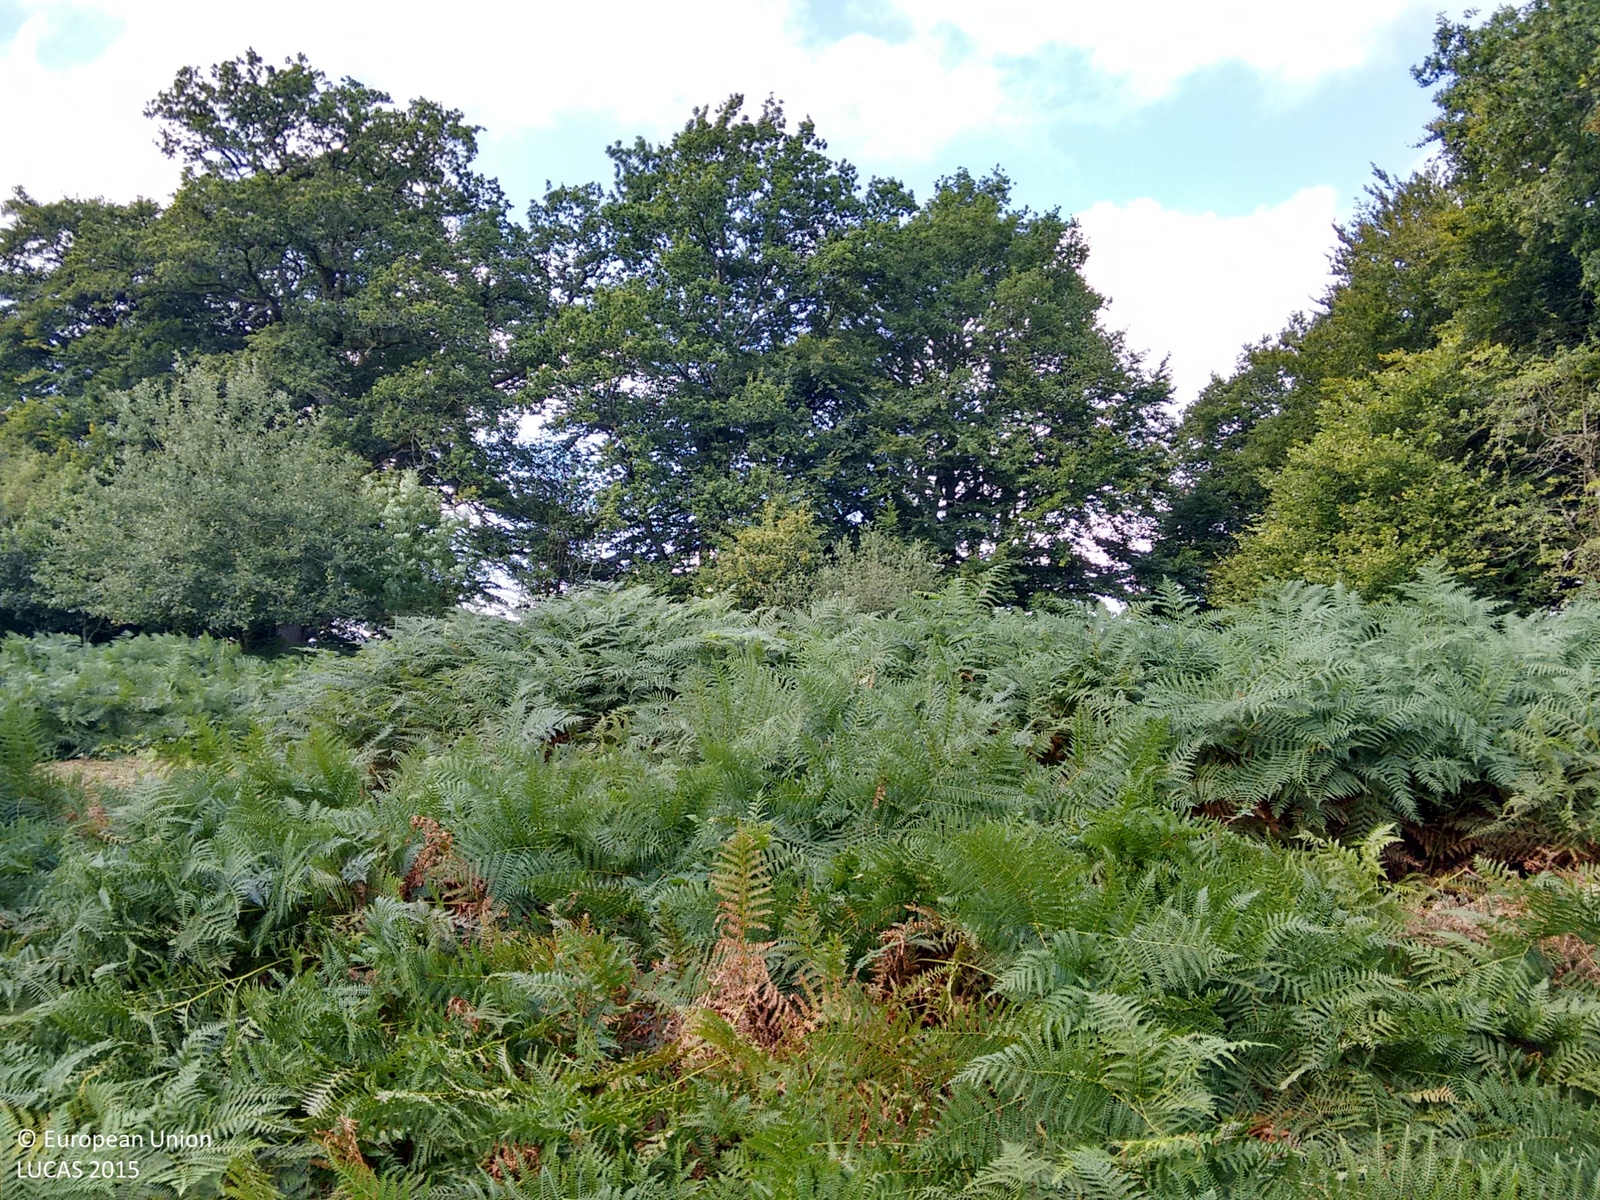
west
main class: Woodland
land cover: Broadleaved woodland
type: mesophytic deciduous forest
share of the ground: > 75 %
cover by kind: herbaceous plants 80 %, broadleaved forest trees 20 %
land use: Agriculture (excluding fallow land and kitchen gardens)
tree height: < 5 m
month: September
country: GB
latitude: 52.1504
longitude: -3.4861
